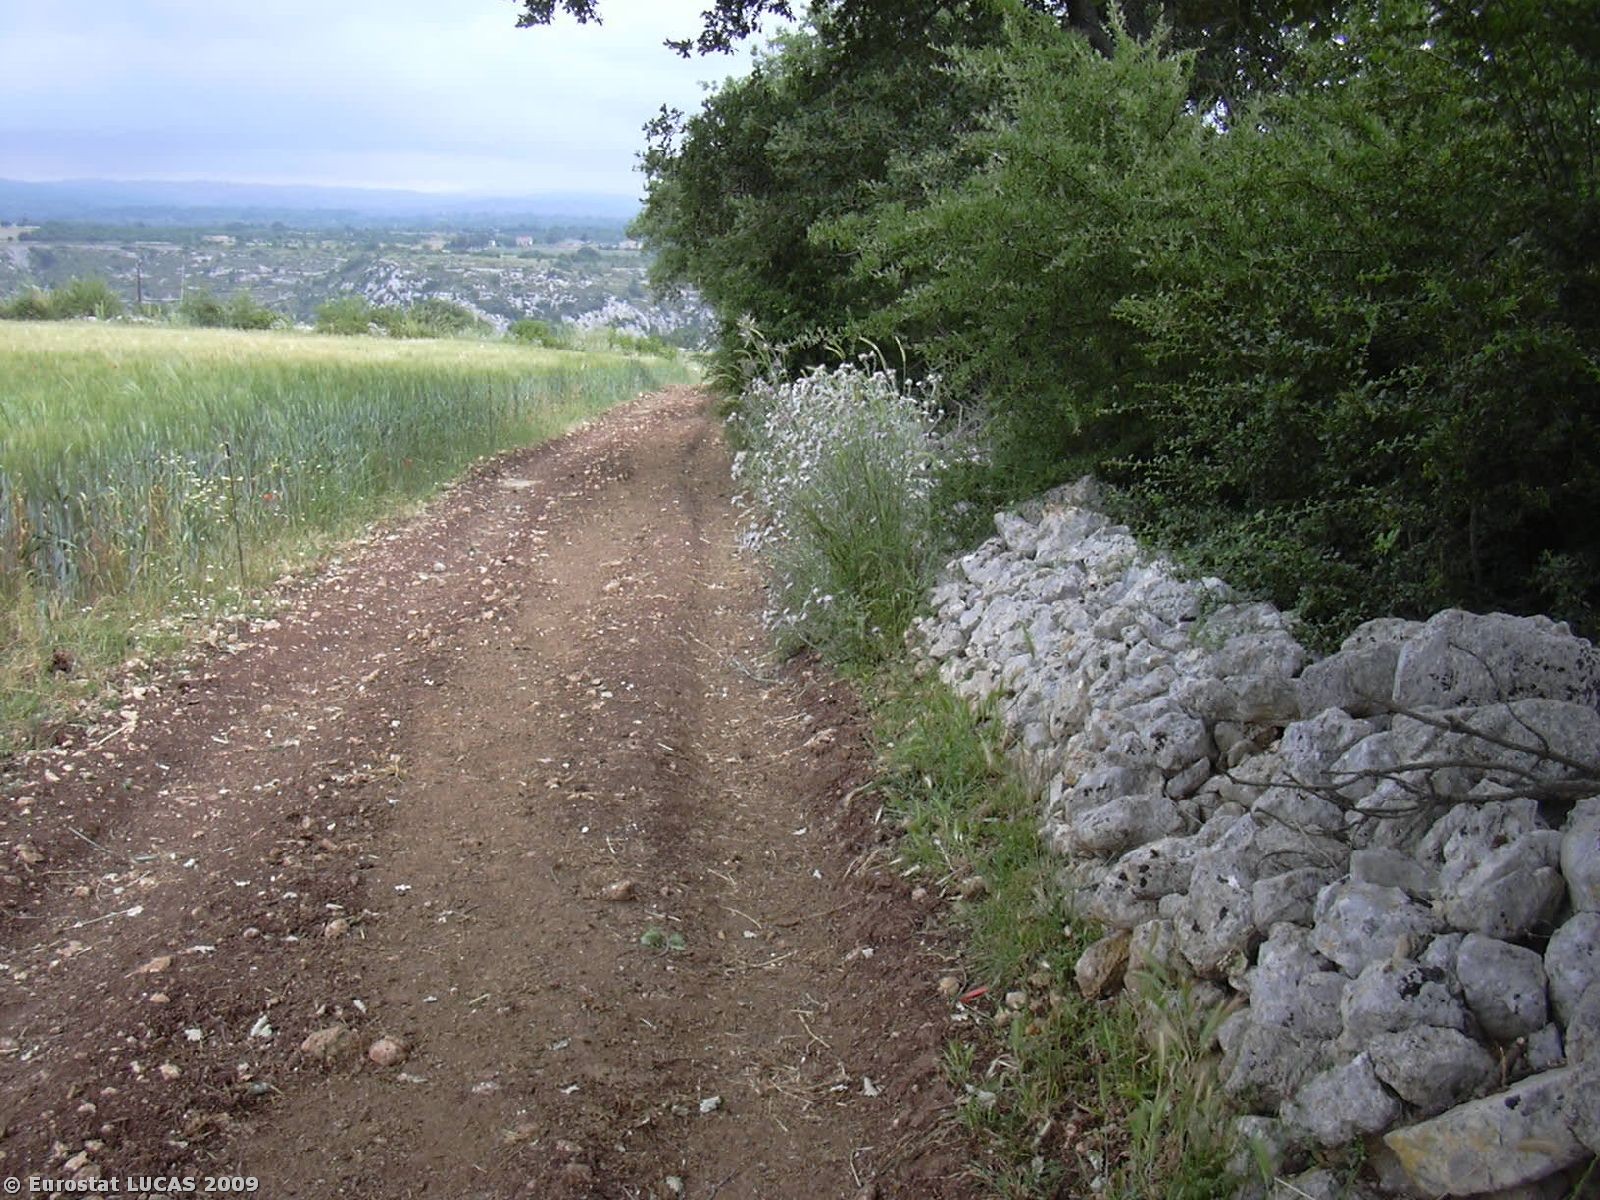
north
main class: Woodland
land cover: Broadleaved woodland
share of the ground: 50 - 75 %
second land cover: Durum wheat
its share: > 75 %
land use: Forestry
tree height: > 5 m
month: May
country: IT
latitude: 37.0732
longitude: 14.9447
